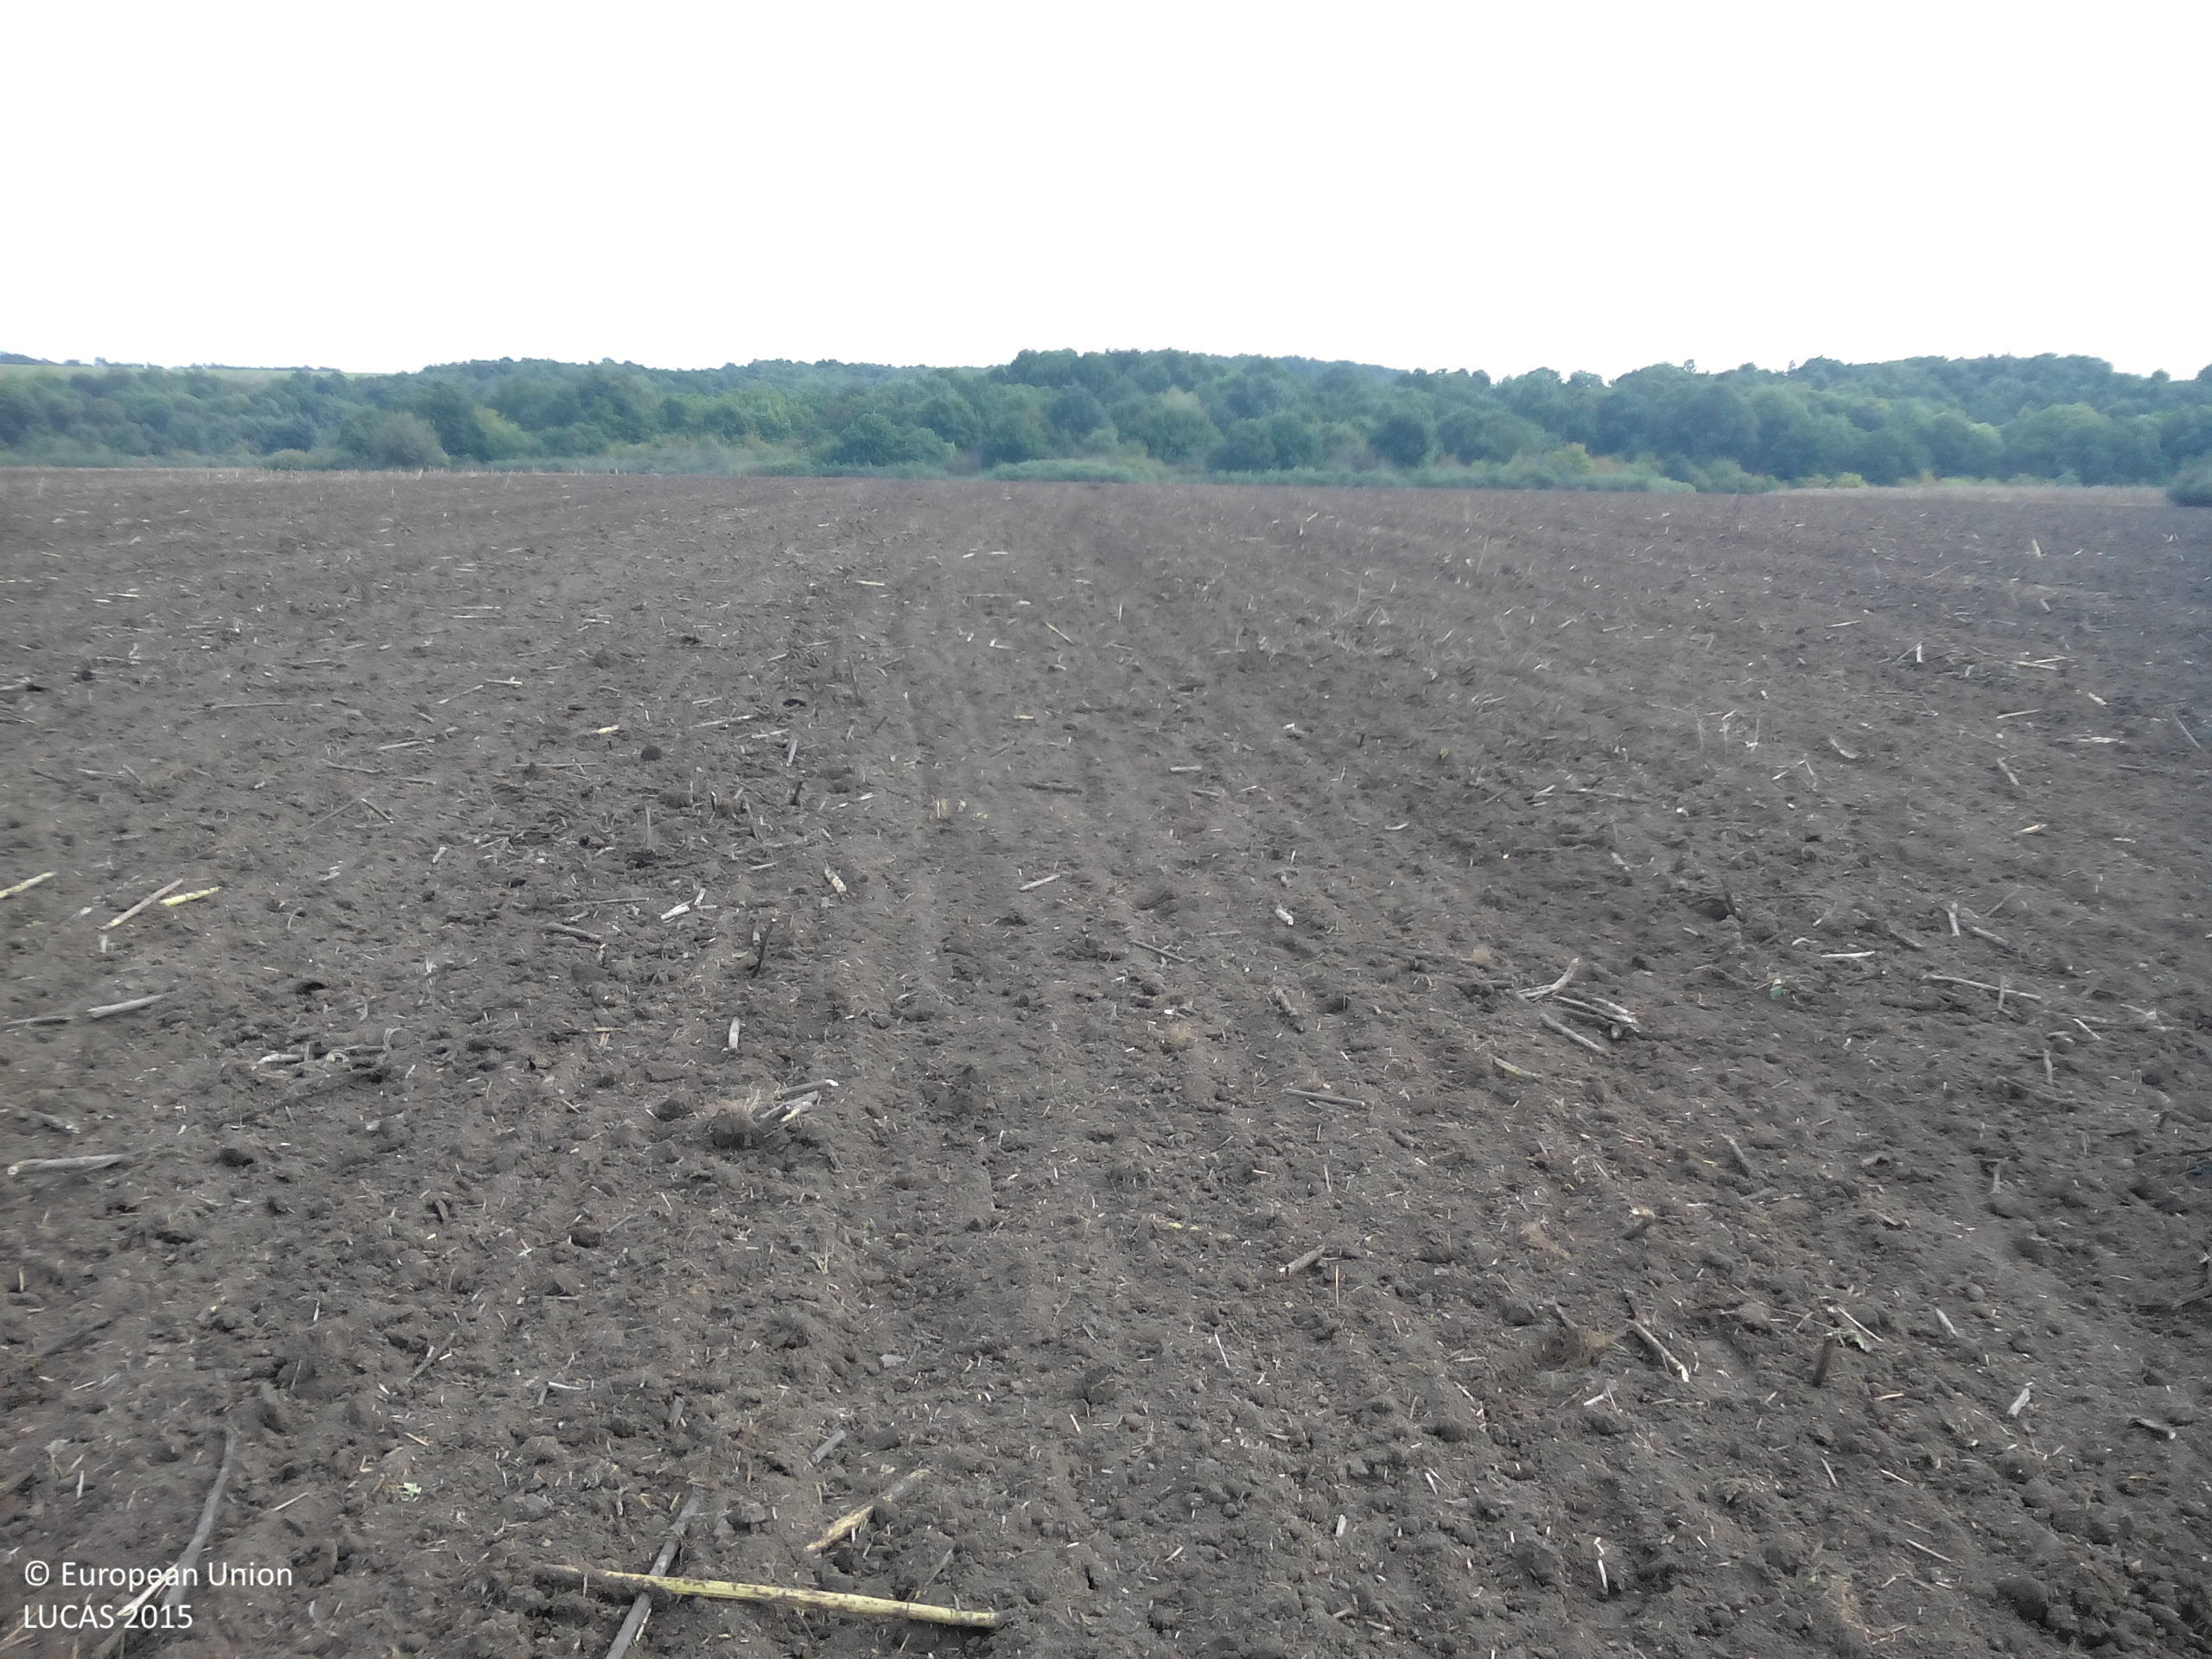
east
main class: Cropland
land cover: Sunflower
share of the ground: < 10 %
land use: Agriculture (excluding fallow land and kitchen gardens)
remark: Harvested field
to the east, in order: Sunflower; Shrubland with sparse tree cover
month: October
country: BG
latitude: 43.3551
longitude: 23.6295
